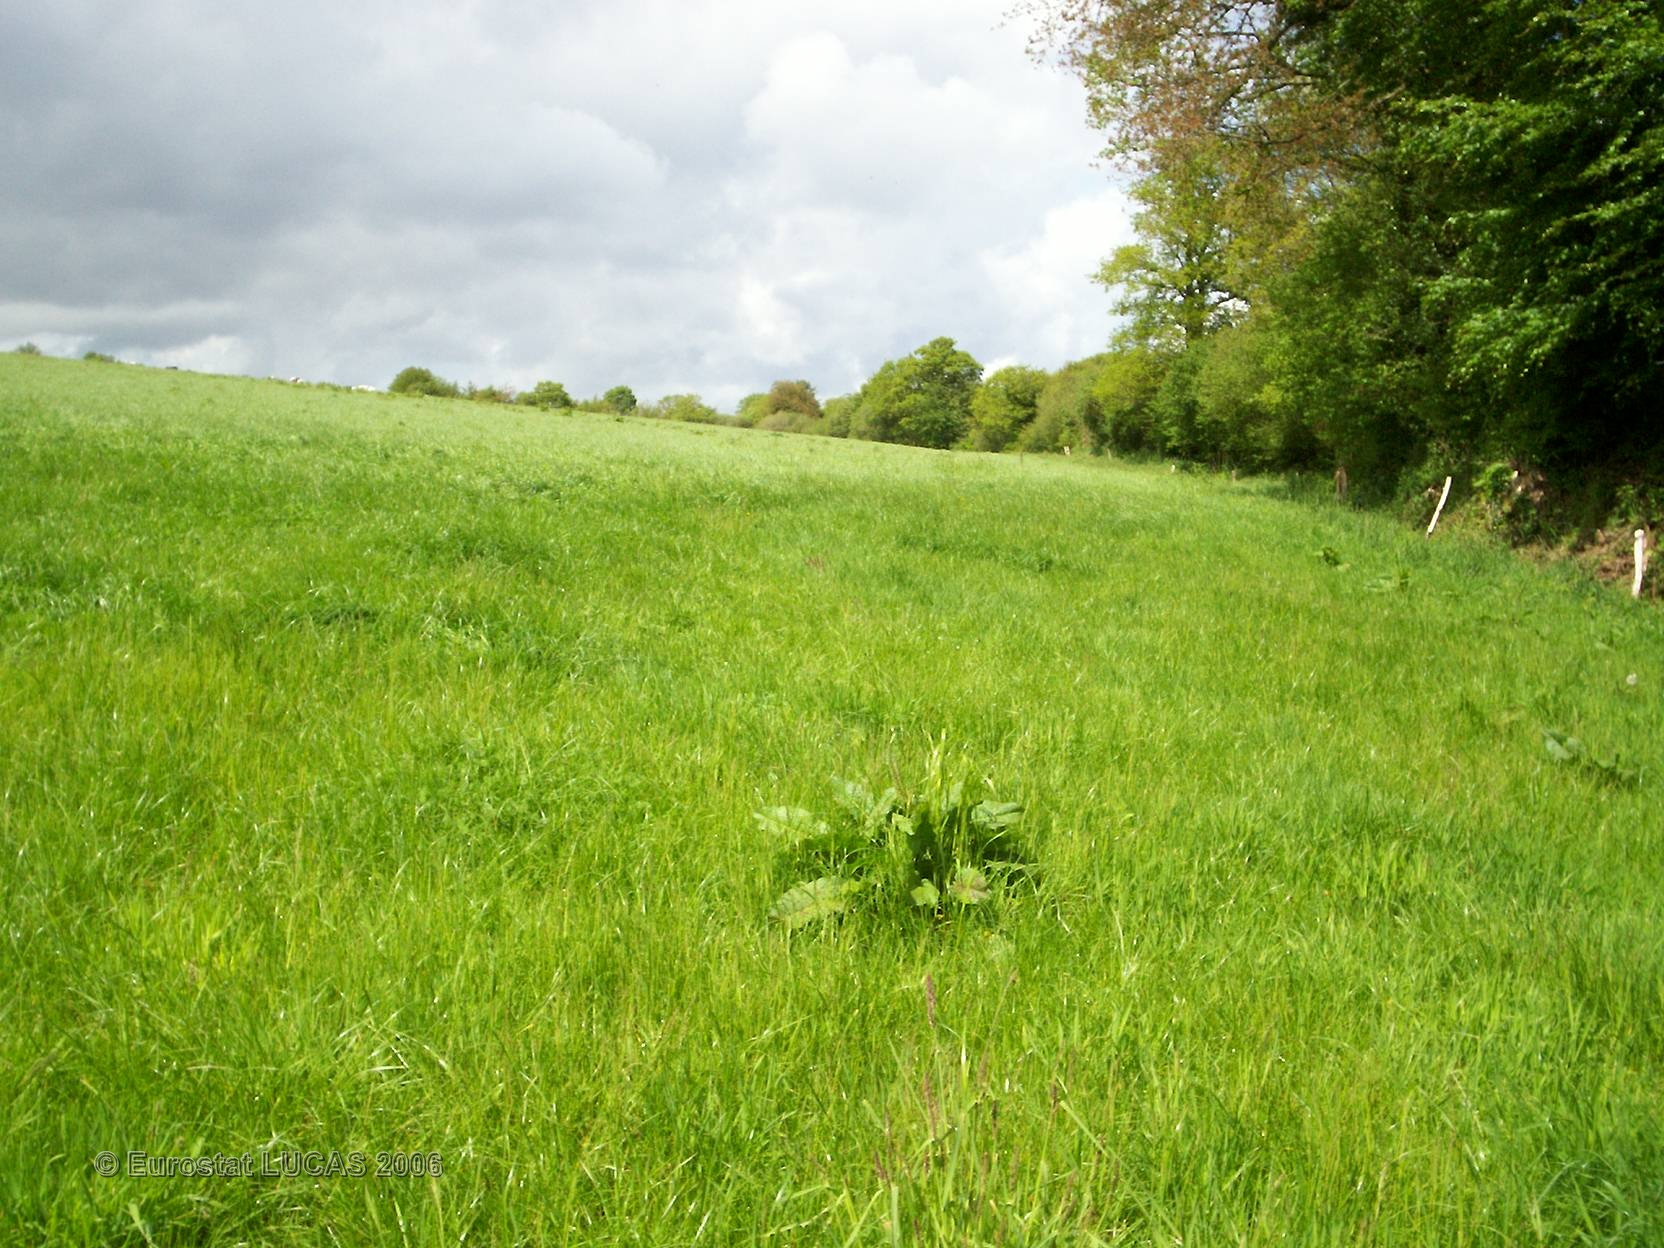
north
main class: Grassland
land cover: Grassland without tree/shrub cover
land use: Agriculture (excluding fallow land and kitchen gardens)
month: May
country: FR
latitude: 48.3866
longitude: -2.9374
